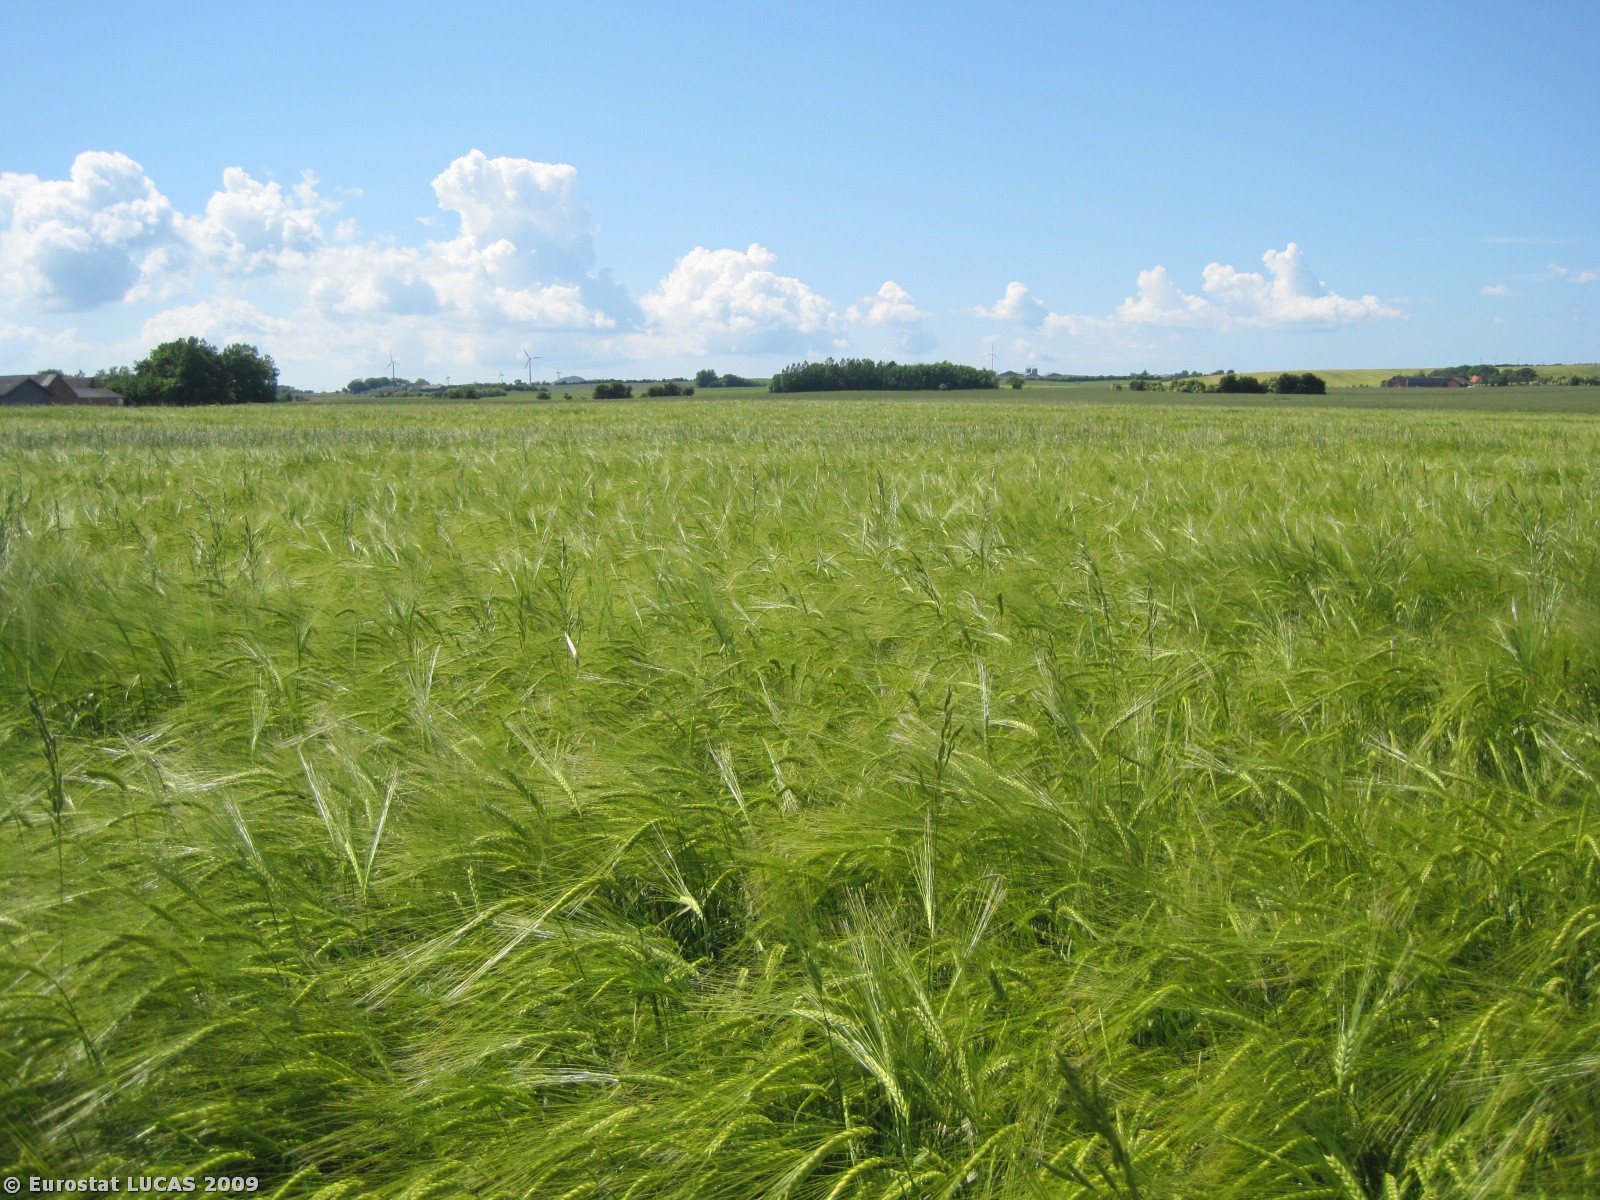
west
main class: Cropland
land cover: Barley
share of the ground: > 75 %
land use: Agriculture (excluding fallow land and kitchen gardens)
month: June
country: DK
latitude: 56.9022
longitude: 8.9015
